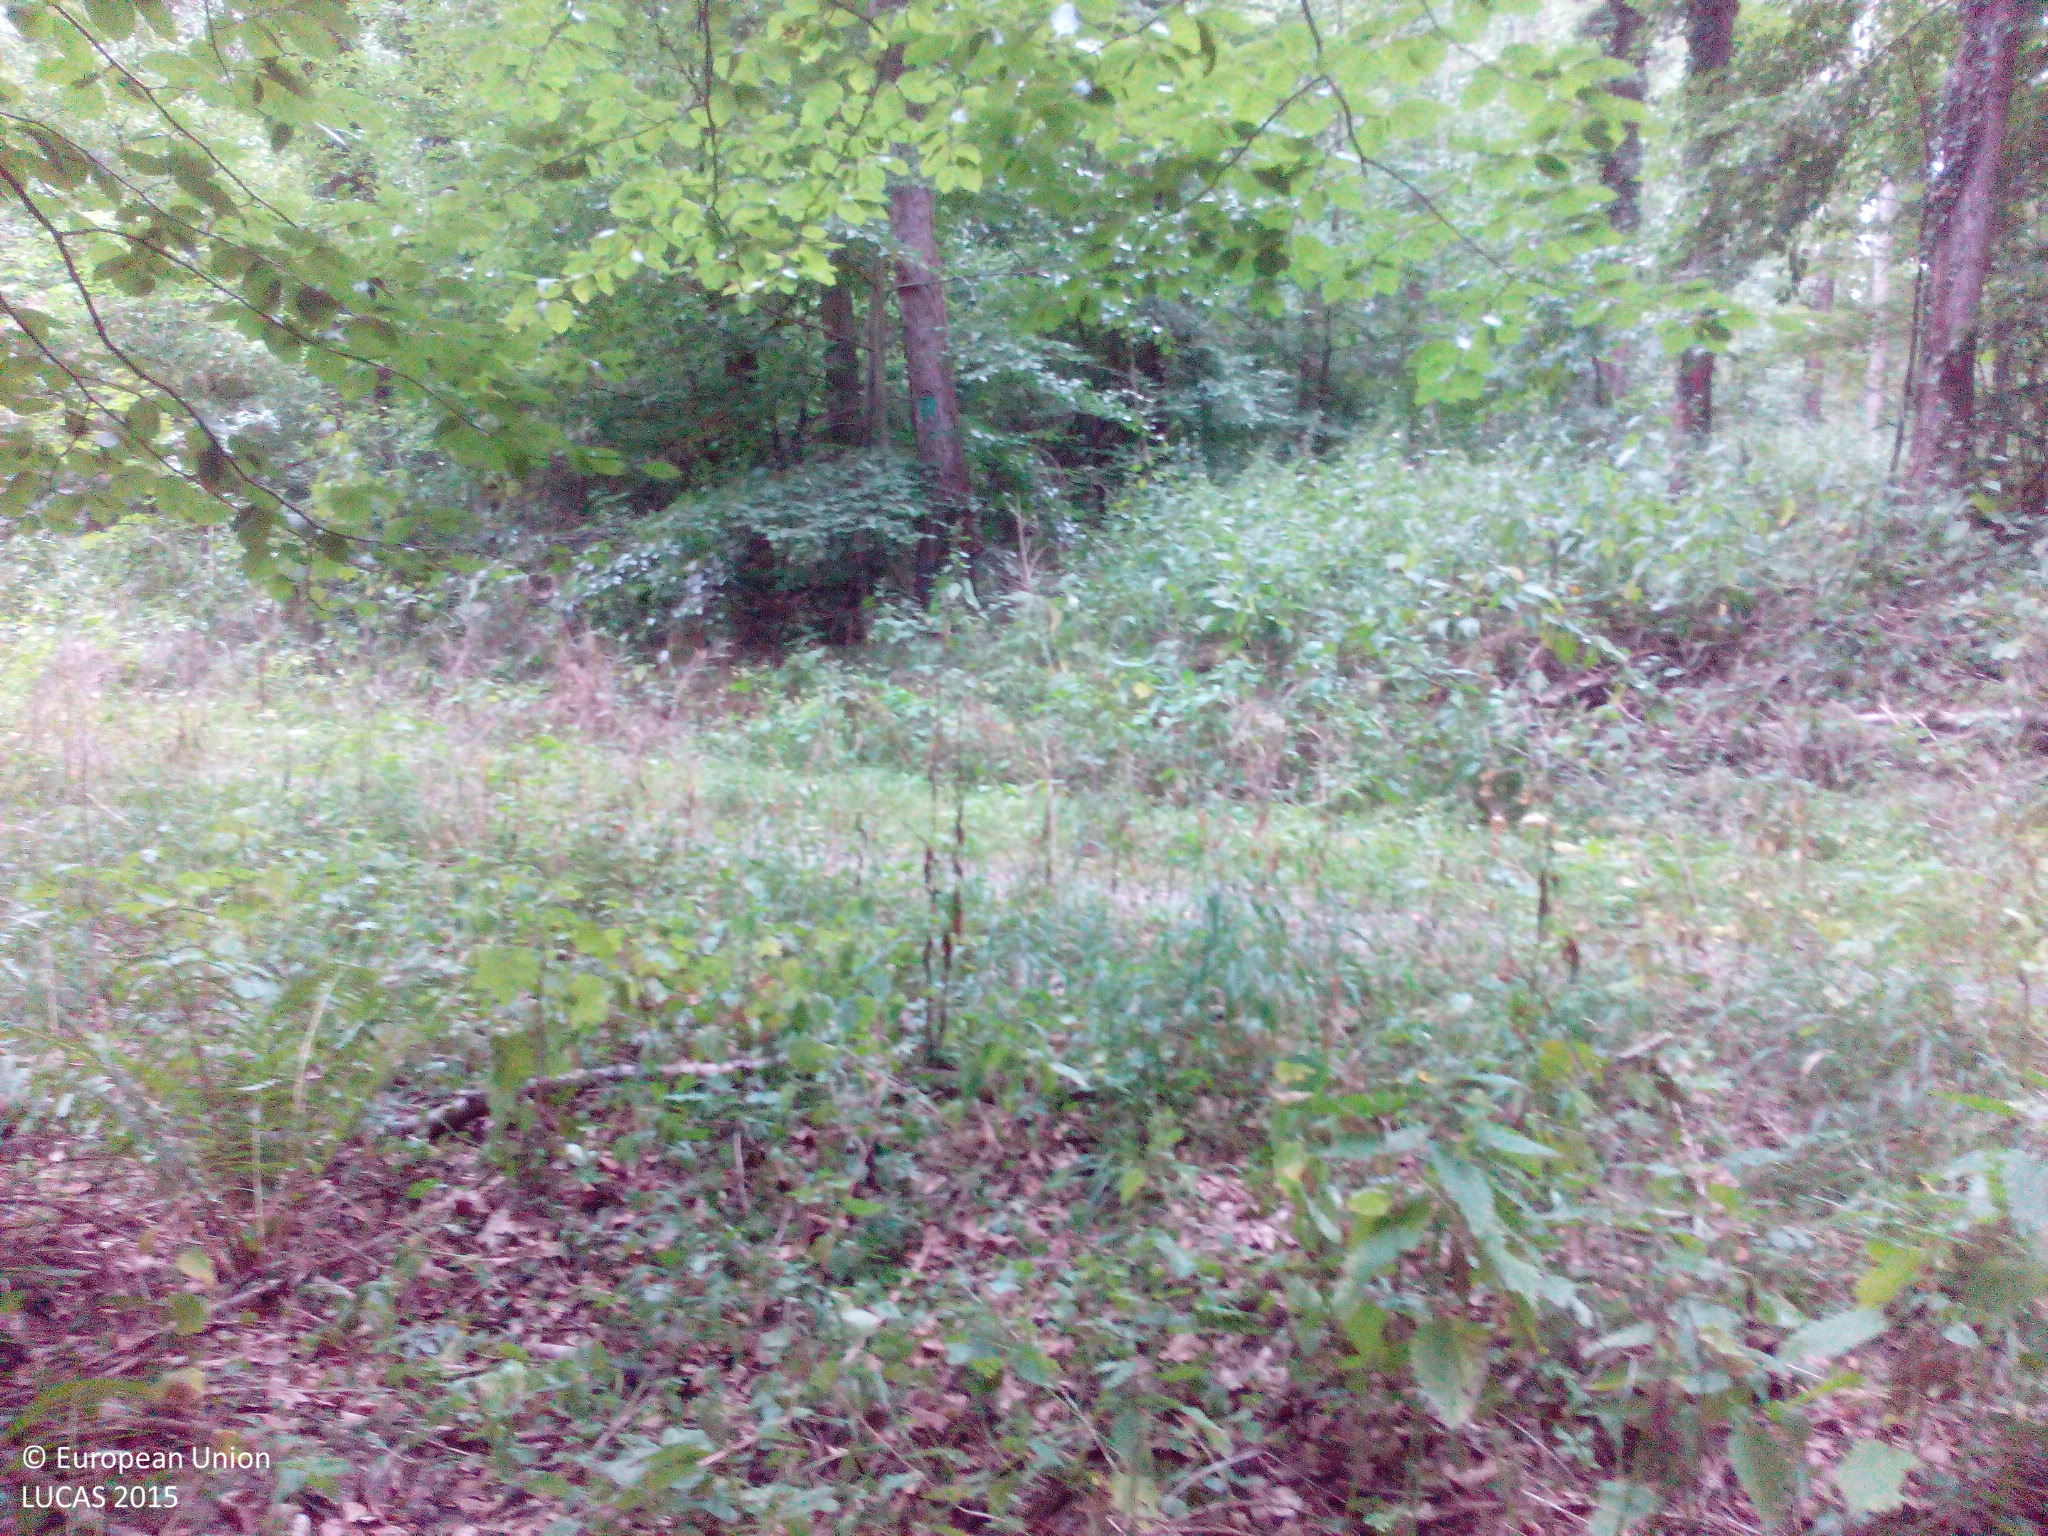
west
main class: Woodland
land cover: Broadleaved woodland
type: beech forest
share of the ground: > 75 %
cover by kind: broadleaved forest trees 85 %, unconsolidated bare surface 10 %, herbaceous plants 5 %
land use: Forestry
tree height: > 5 m
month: August
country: DE
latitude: 50.3469
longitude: 8.0189
